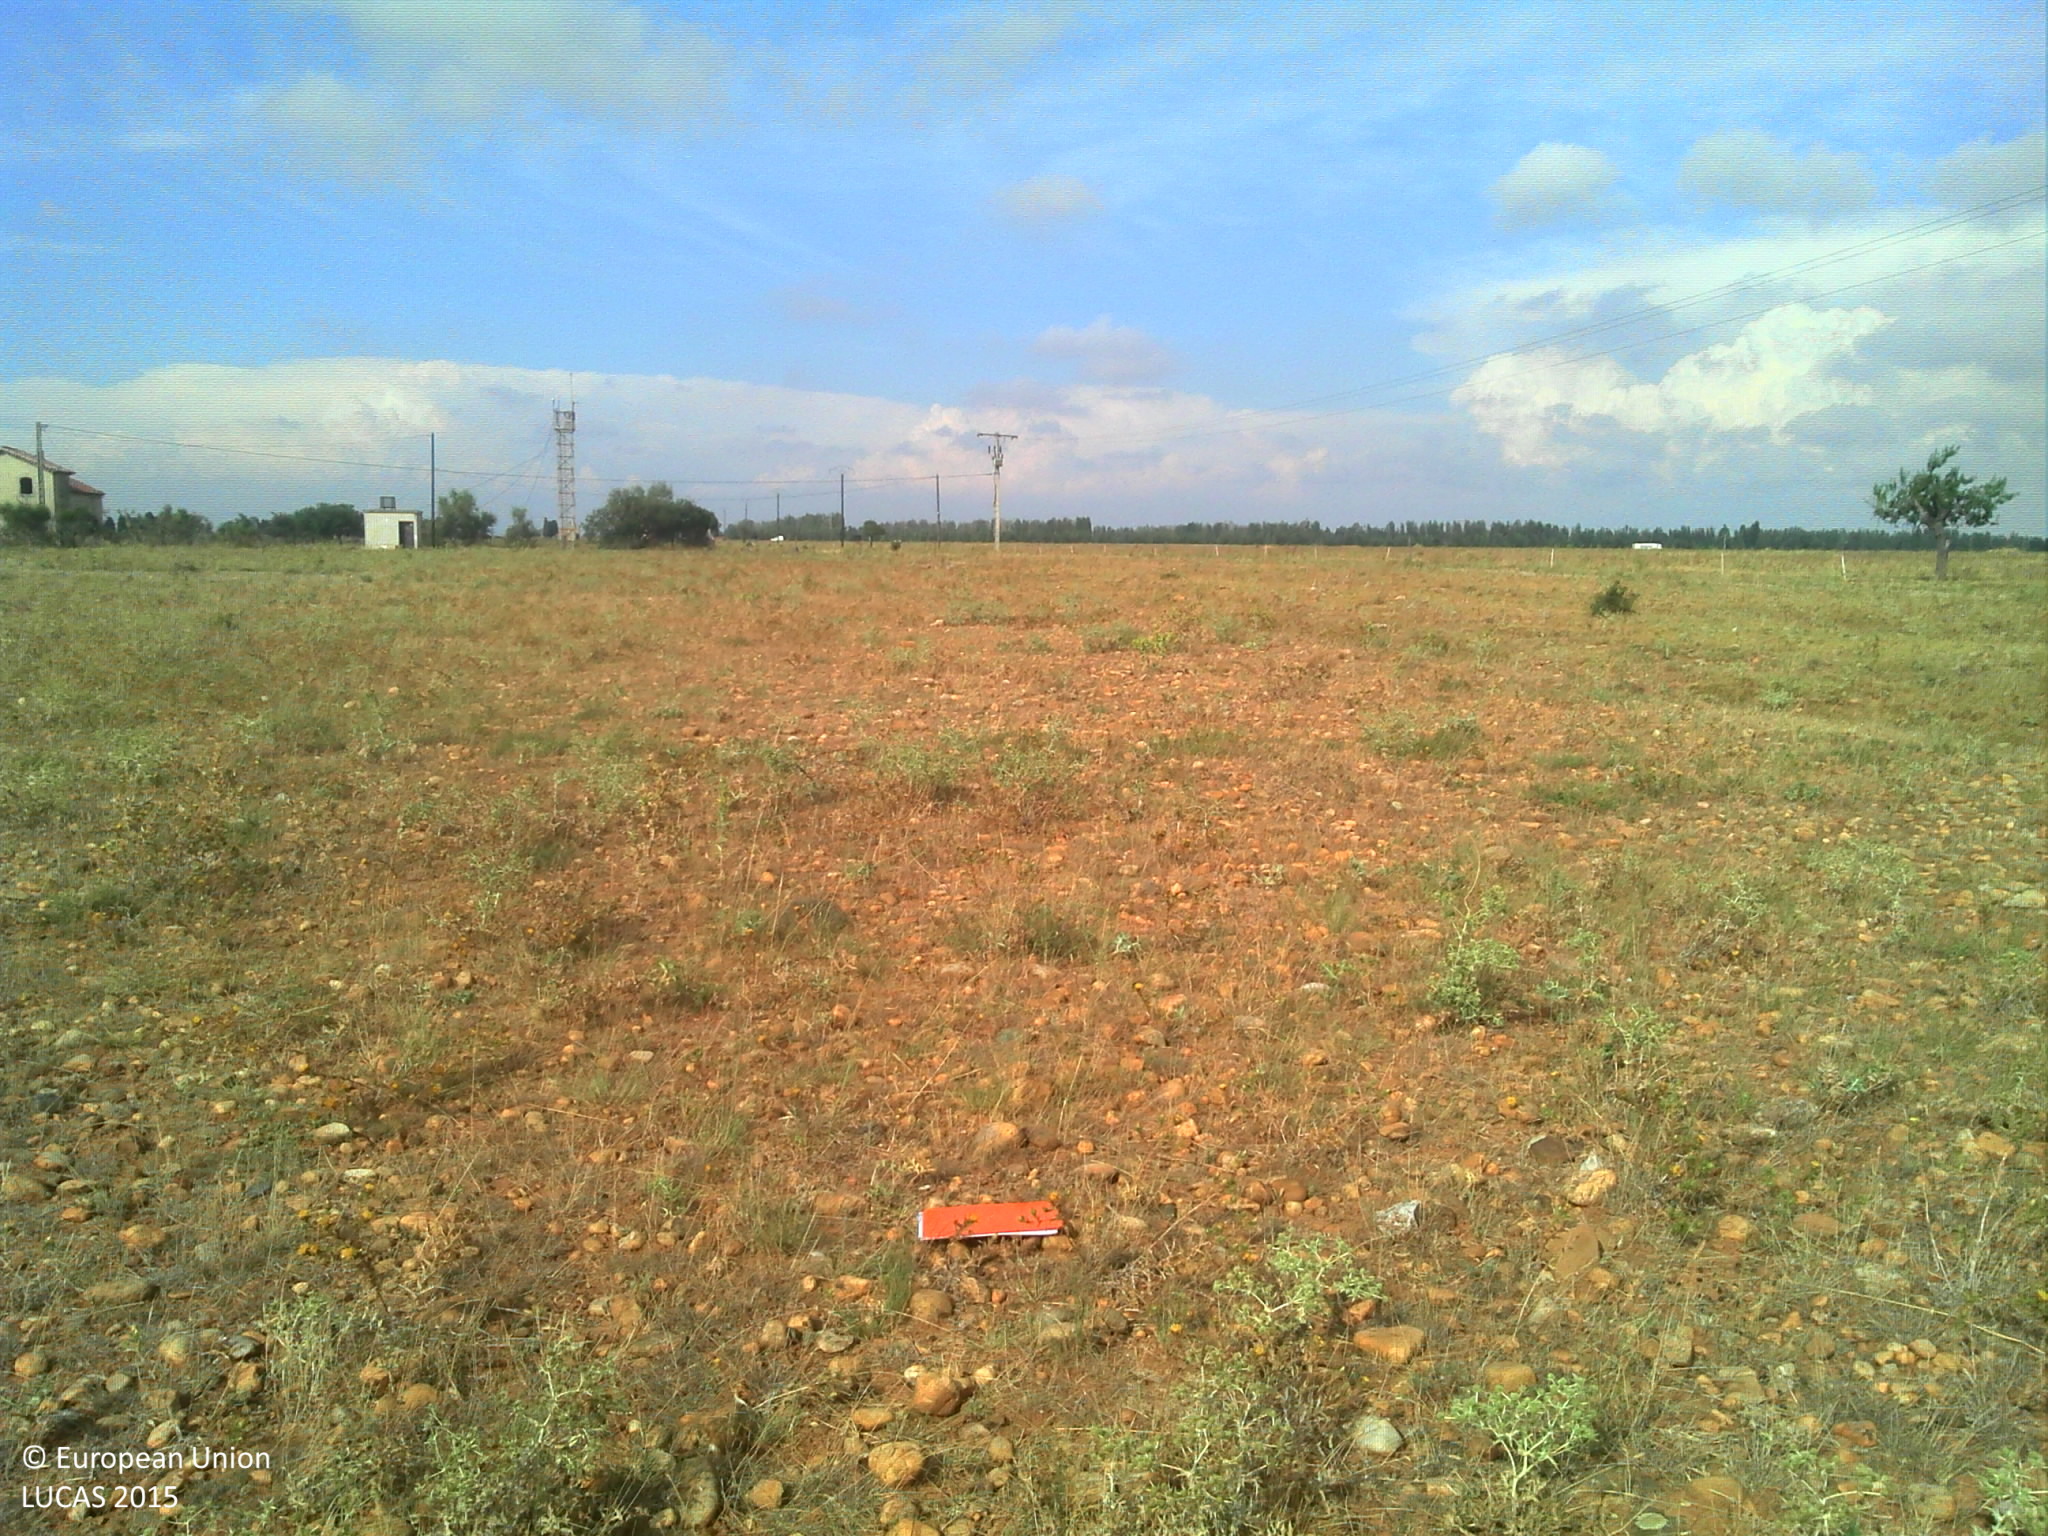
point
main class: Grassland
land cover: Spontaneously vegetated surfaces
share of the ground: 25 - 50 %
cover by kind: unconsolidated bare surface 60 %, herbaceous plants 35 %, shrubs 5 %
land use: Agriculture (excluding fallow land and kitchen gardens)
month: July
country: FR
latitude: 43.4998
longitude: 4.8528
